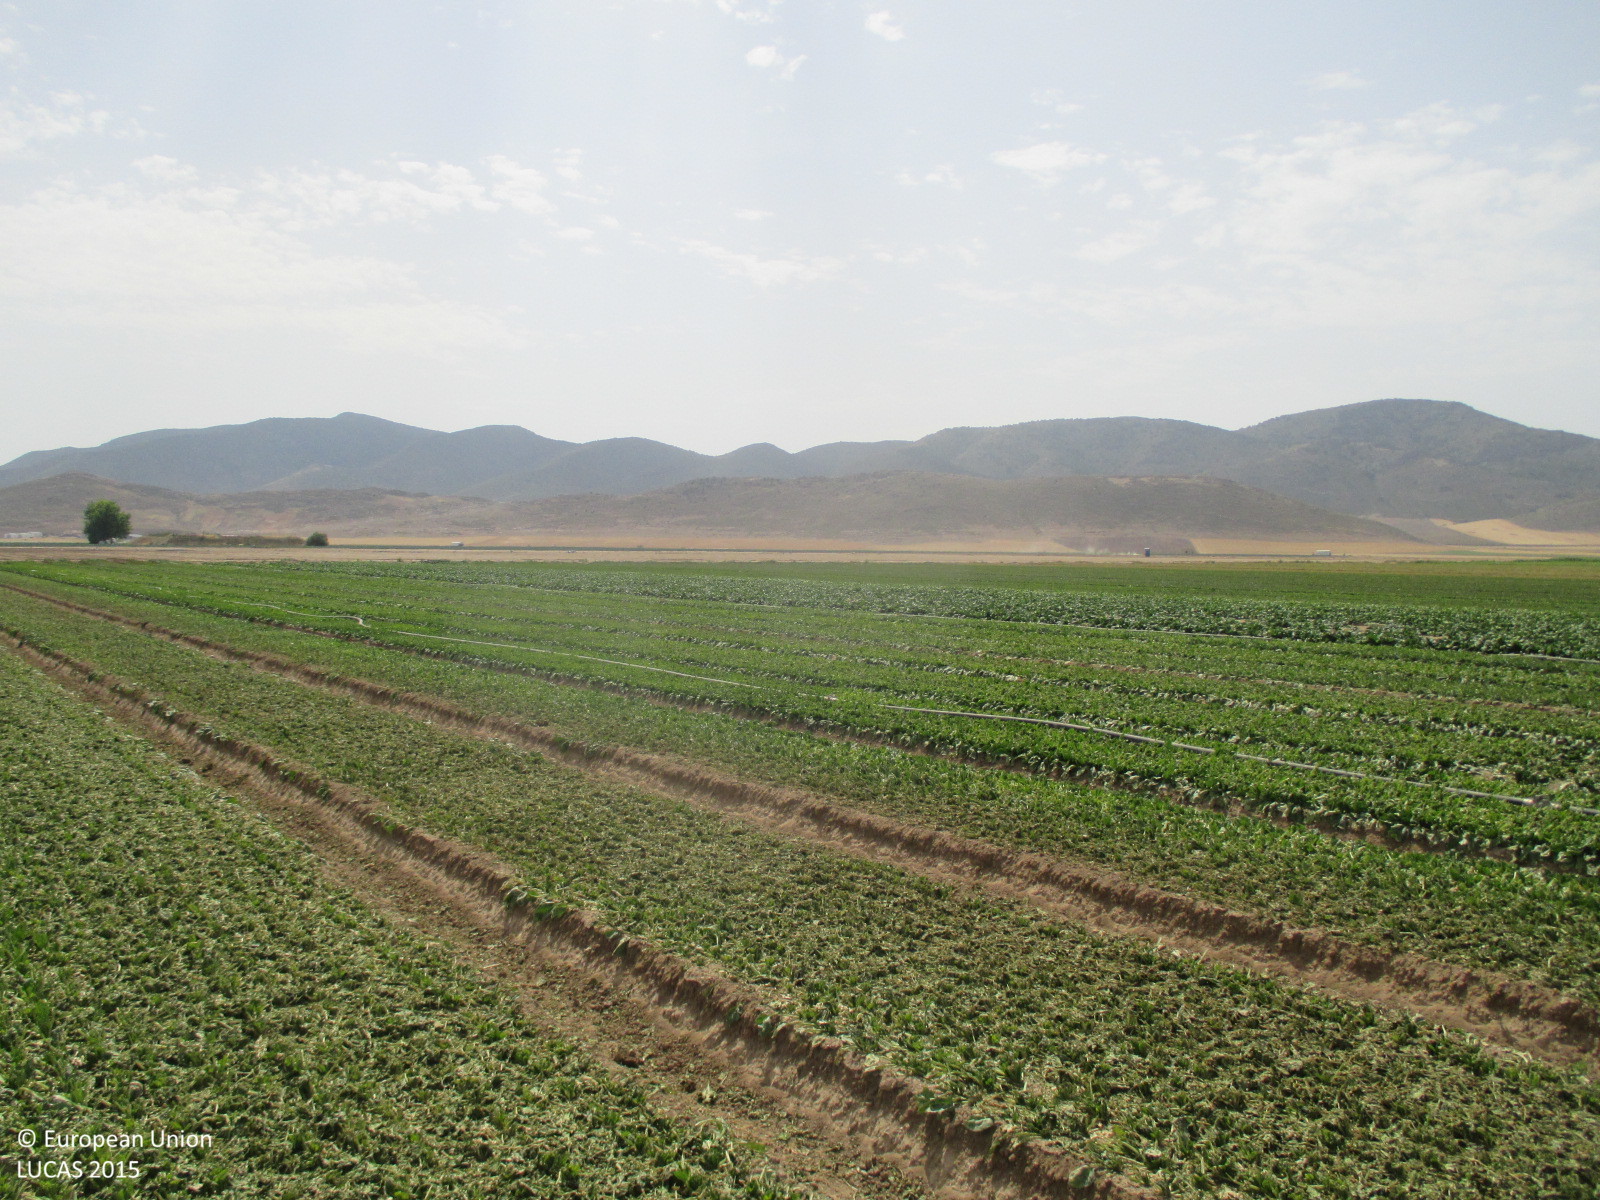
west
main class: Cropland
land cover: Other fresh vegetables
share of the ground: 50 - 75 %
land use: Agriculture (excluding fallow land and kitchen gardens)
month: July
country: ES
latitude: 37.8652
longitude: -2.4141
